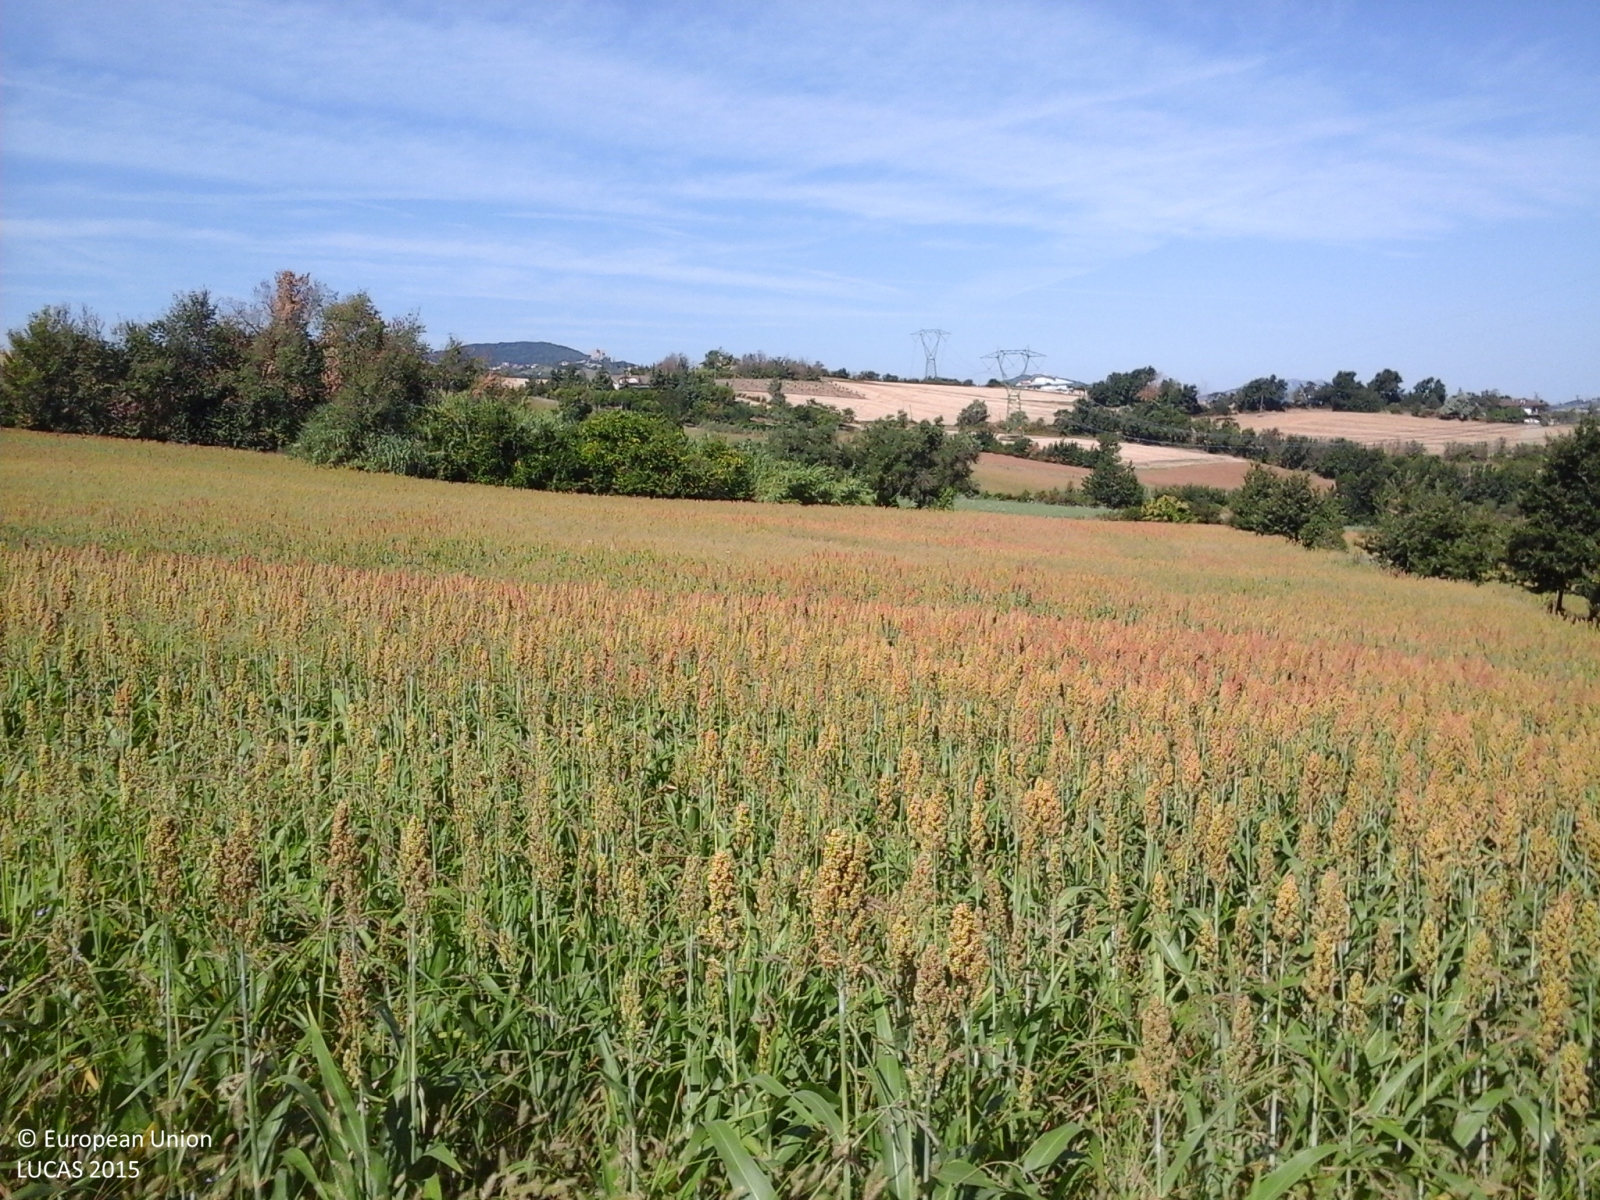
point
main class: Cropland
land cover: Other cereals
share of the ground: > 75 %
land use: Agriculture (excluding fallow land and kitchen gardens)
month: July
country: IT
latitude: 43.9011
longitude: 12.6705
